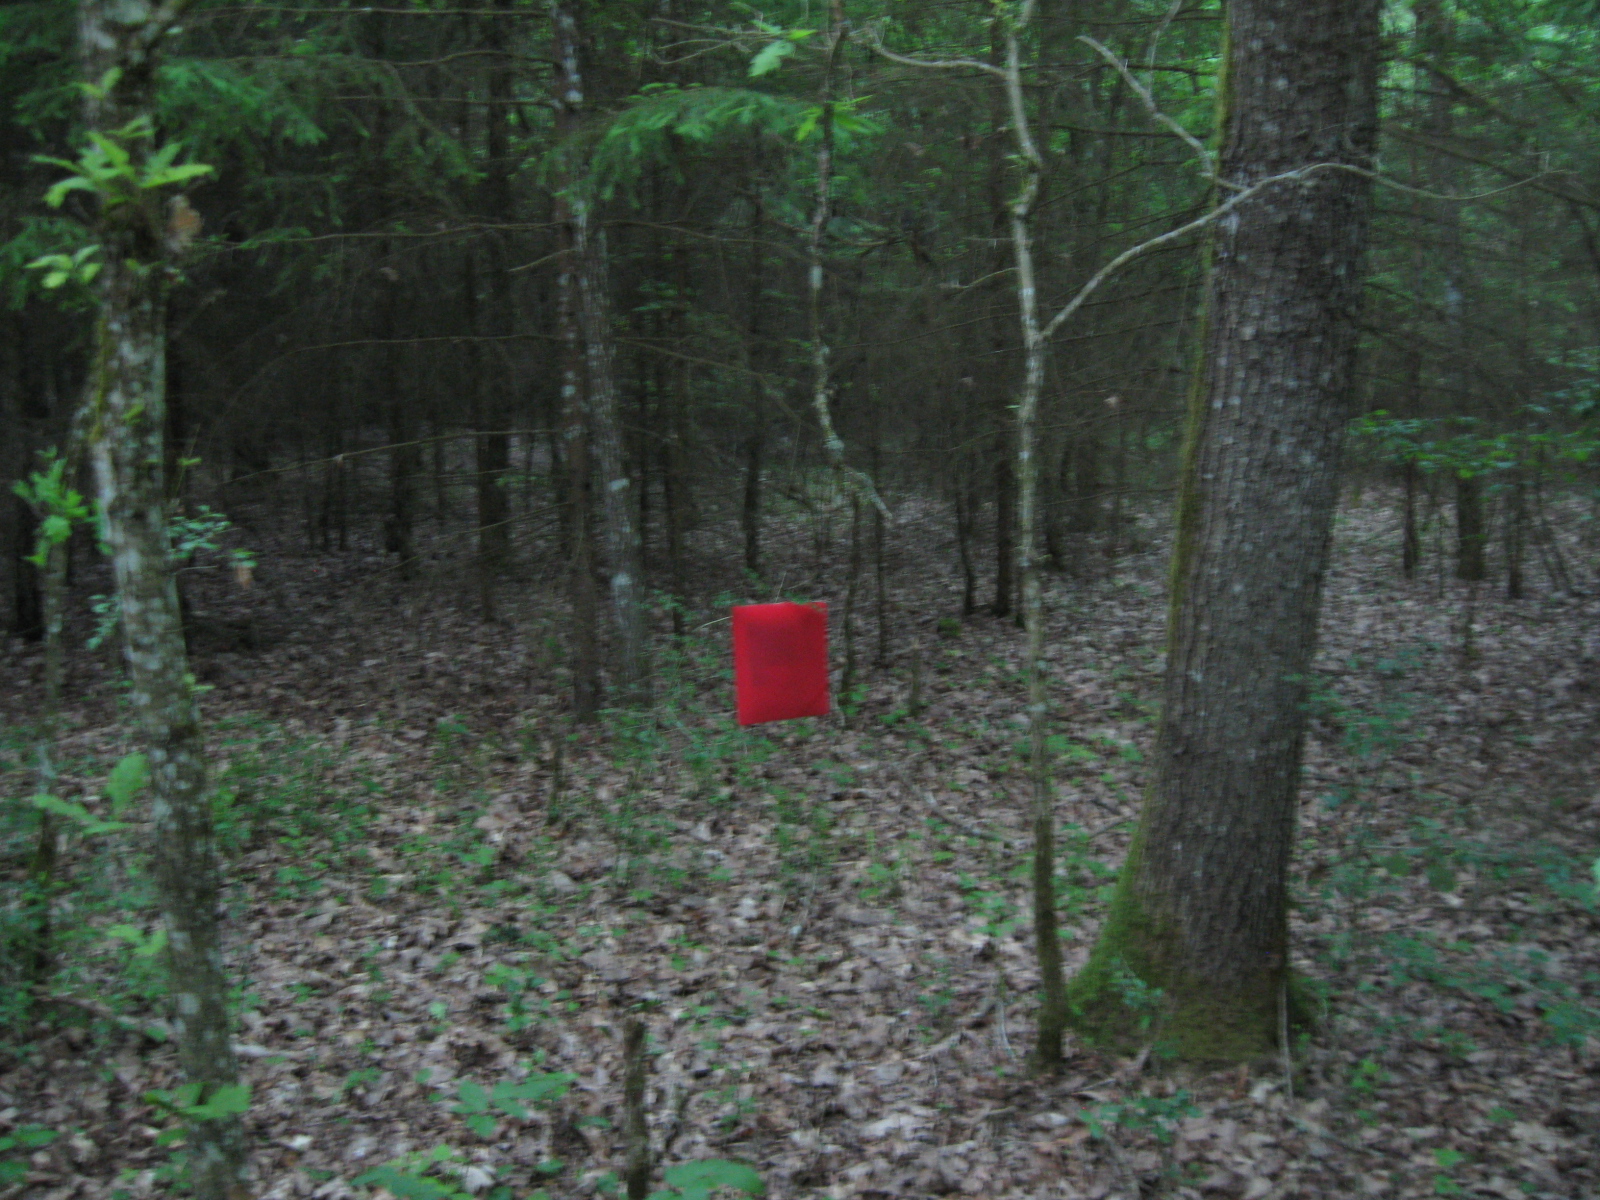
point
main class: Woodland
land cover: Spruce dominated mixed woodland
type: hemiboreal forest and nemoral coniferous forest and mixed broadleaved-coniferous forest
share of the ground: > 75 %
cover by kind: broadleaved forest trees 60 %, coniferous forest trees 40 %
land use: Forestry
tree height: > 5 m
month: June
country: LT
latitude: 54.4548
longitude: 23.9263
